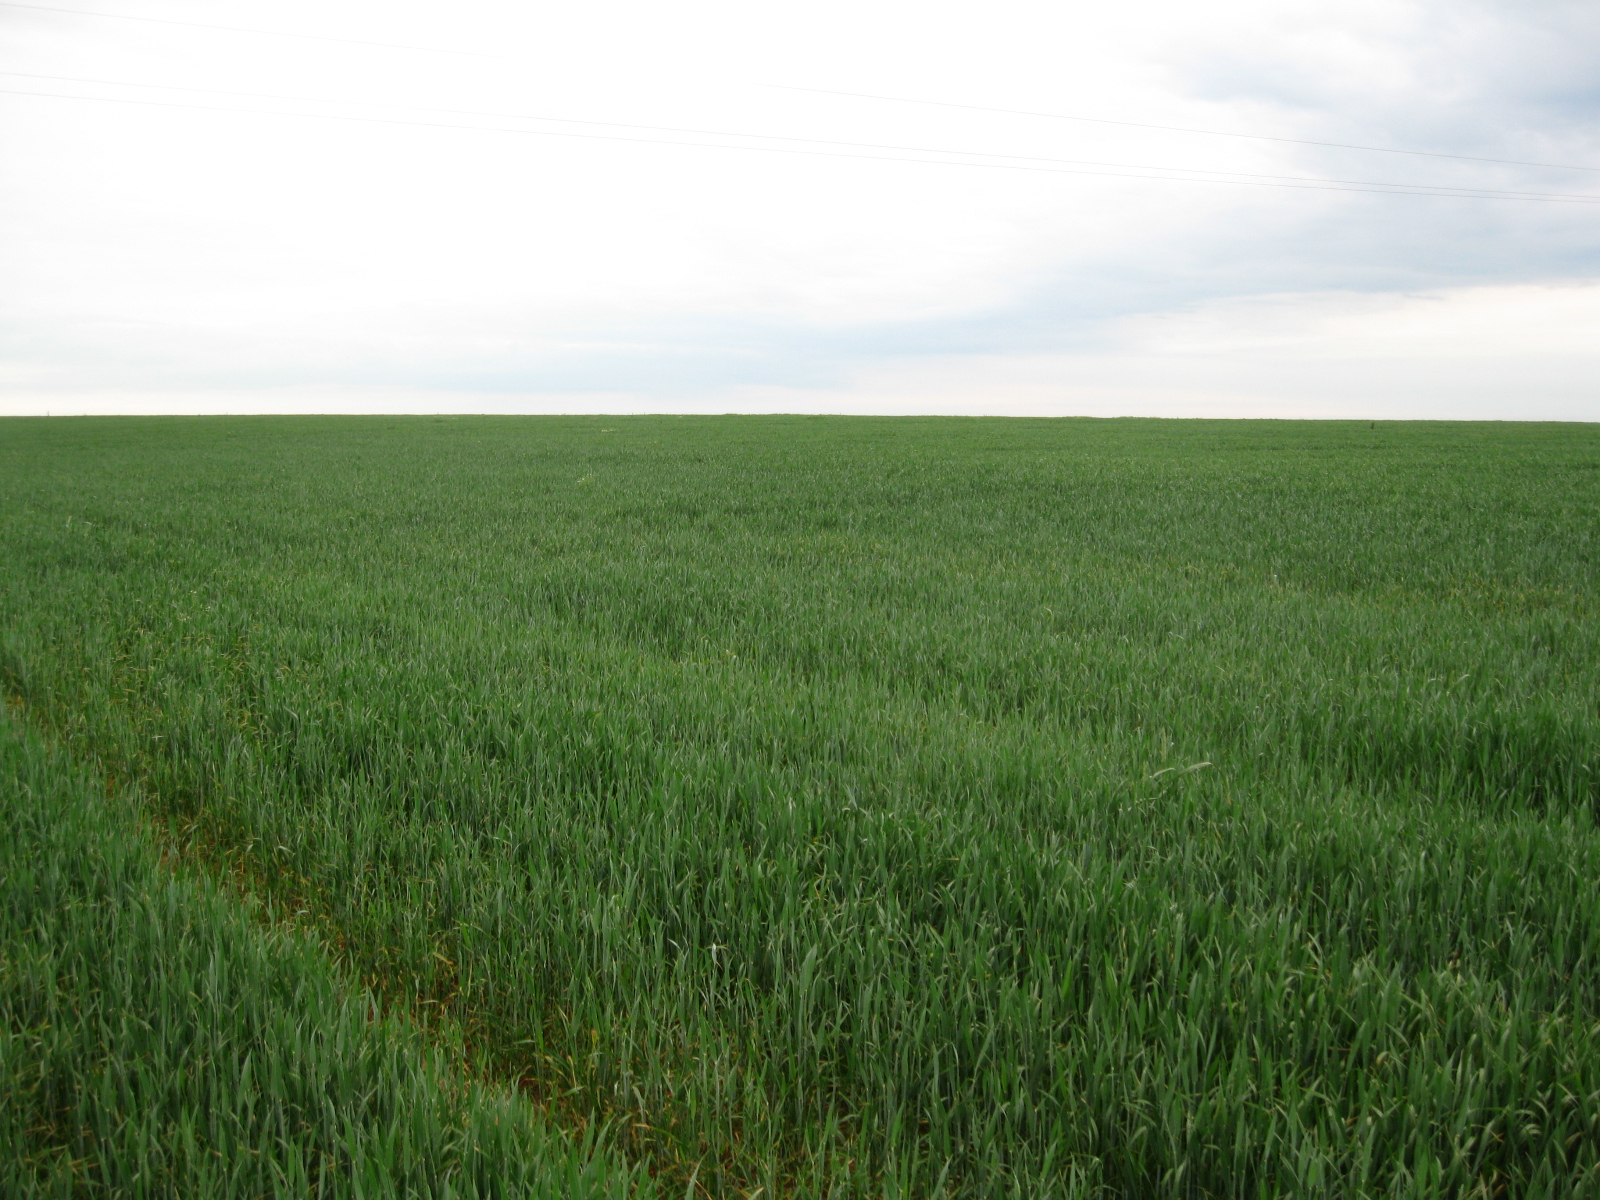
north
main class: Cropland
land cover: Common wheat
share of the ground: > 75 %
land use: Agriculture (excluding fallow land and kitchen gardens)
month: June
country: LT
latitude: 55.1189
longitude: 23.8699
